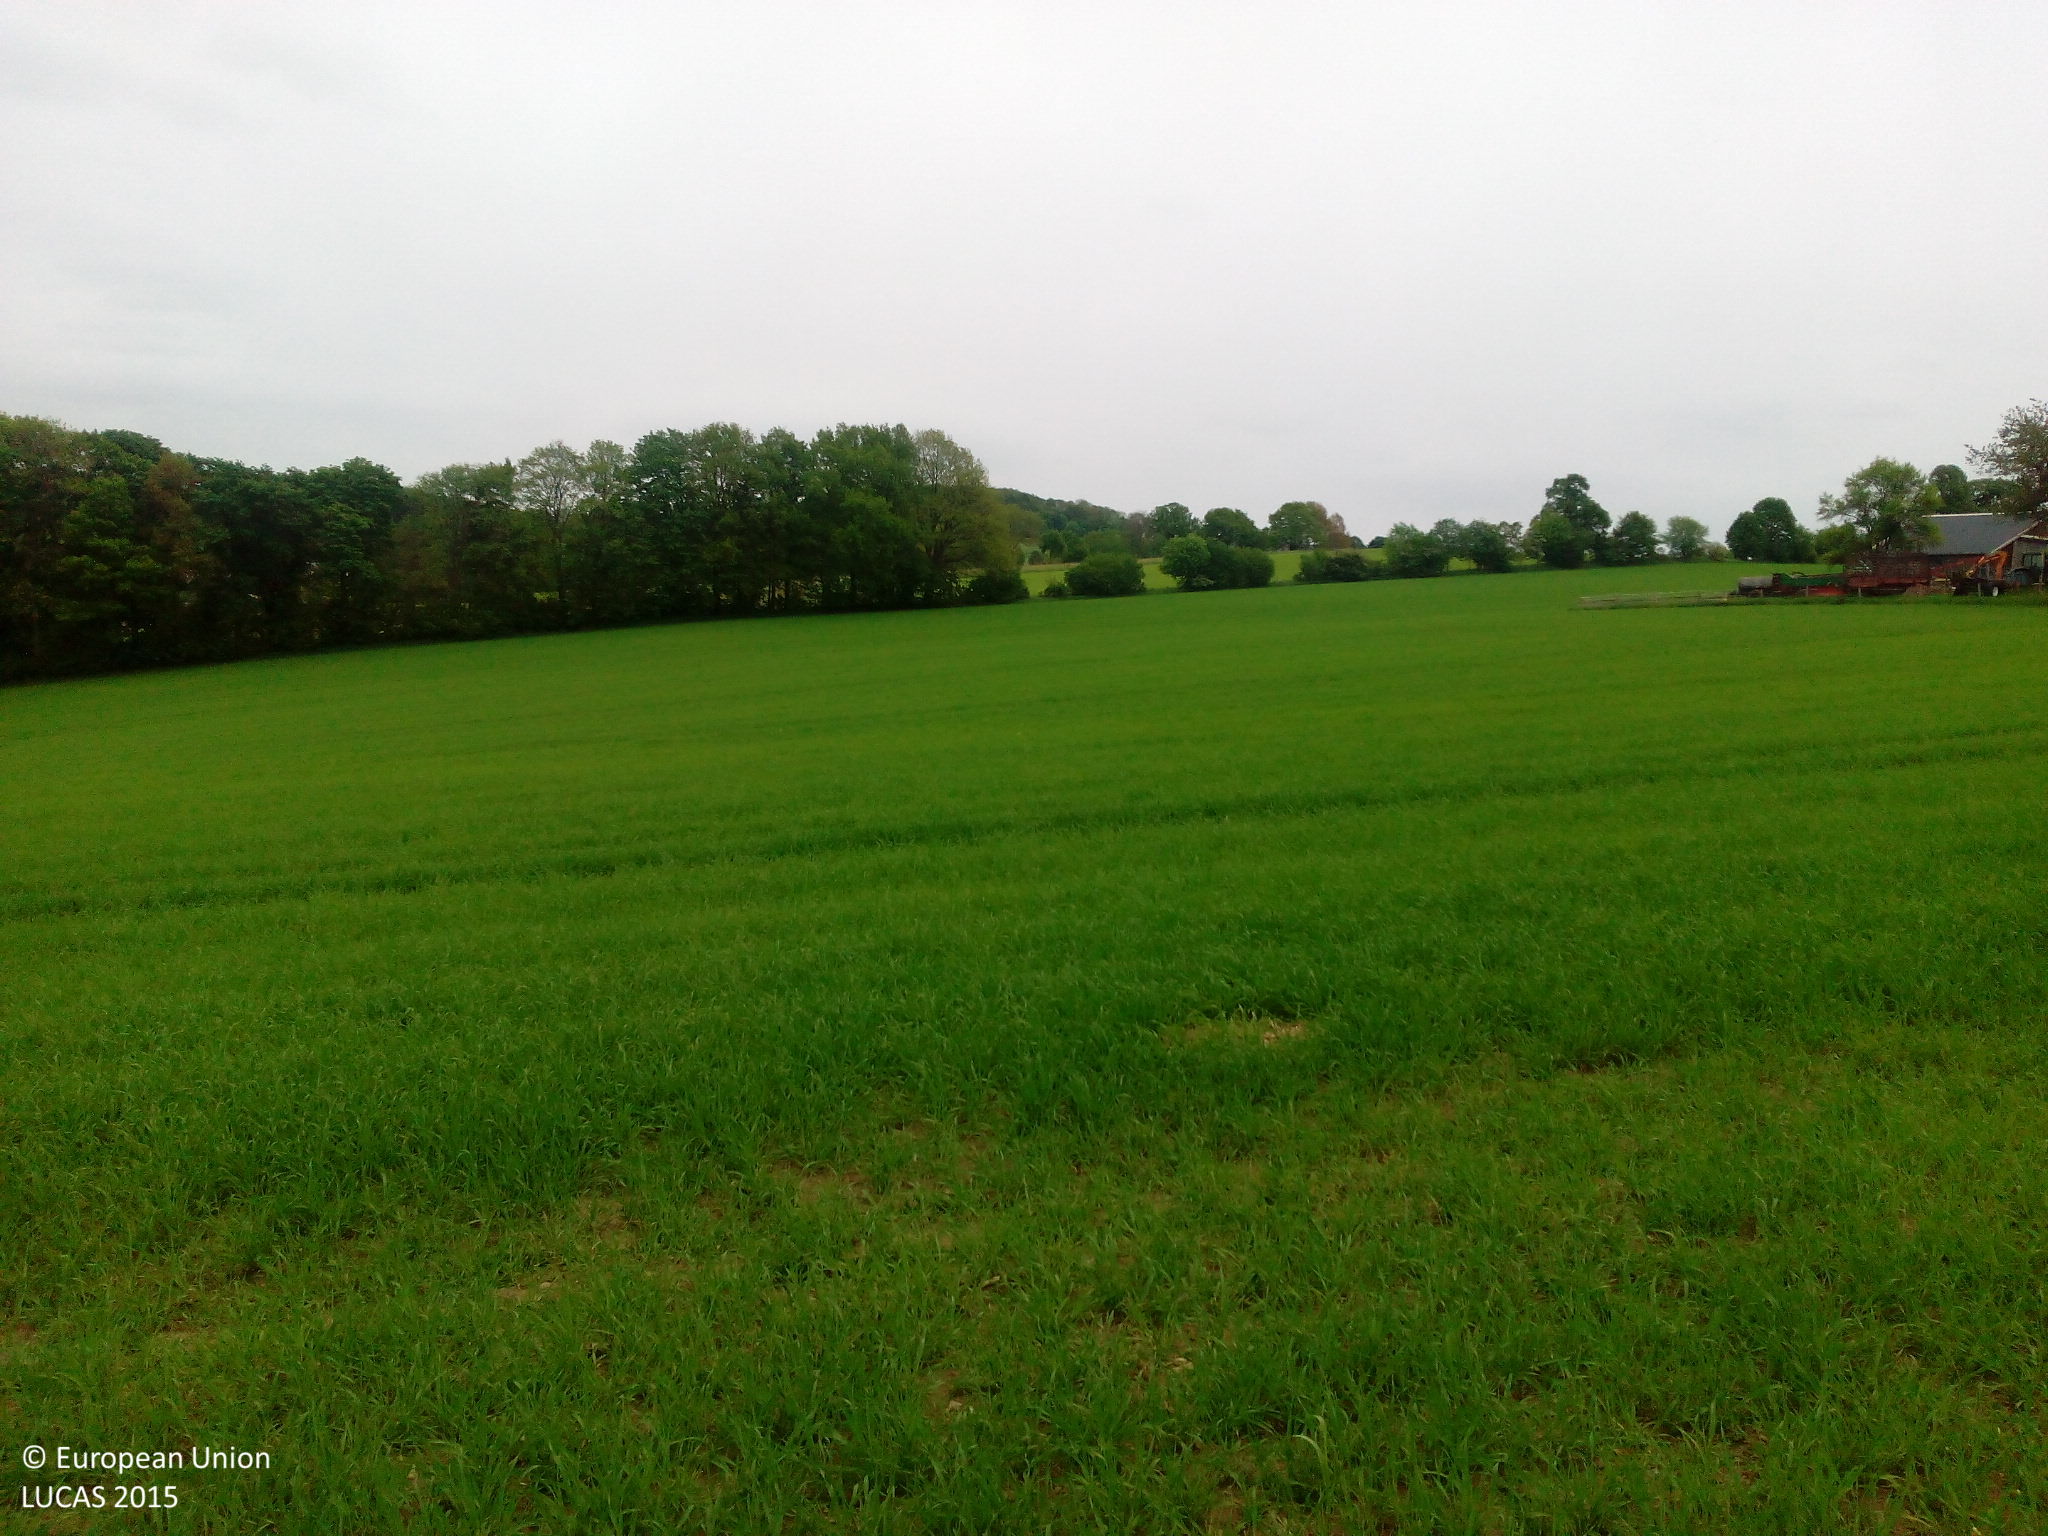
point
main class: Cropland
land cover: Barley
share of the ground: > 75 %
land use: Agriculture (excluding fallow land and kitchen gardens)
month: May
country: DE
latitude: 50.6827
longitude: 13.0713
